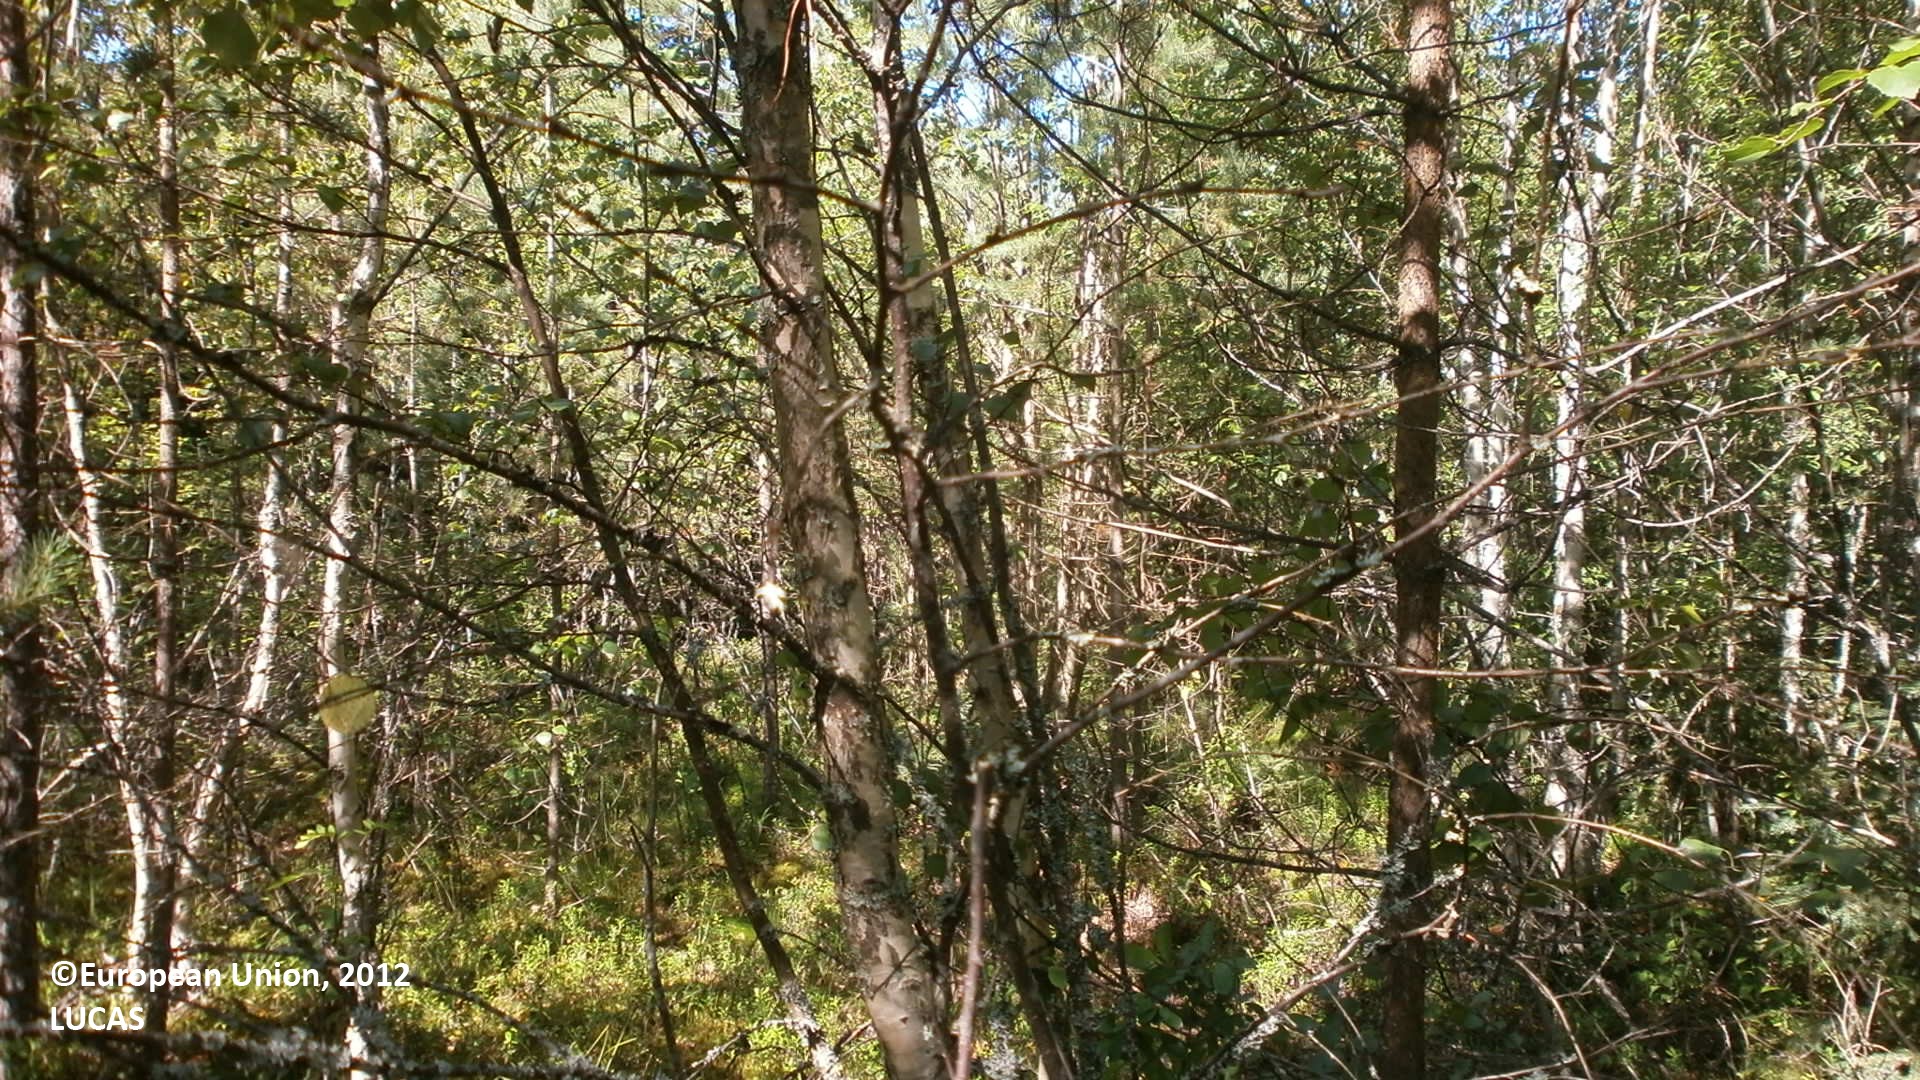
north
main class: Woodland
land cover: Pine dominated mixed woodland
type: boreal forest
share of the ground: > 75 %
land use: Forestry
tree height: > 5 m
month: July
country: FI
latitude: 64.1296
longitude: 23.9280
